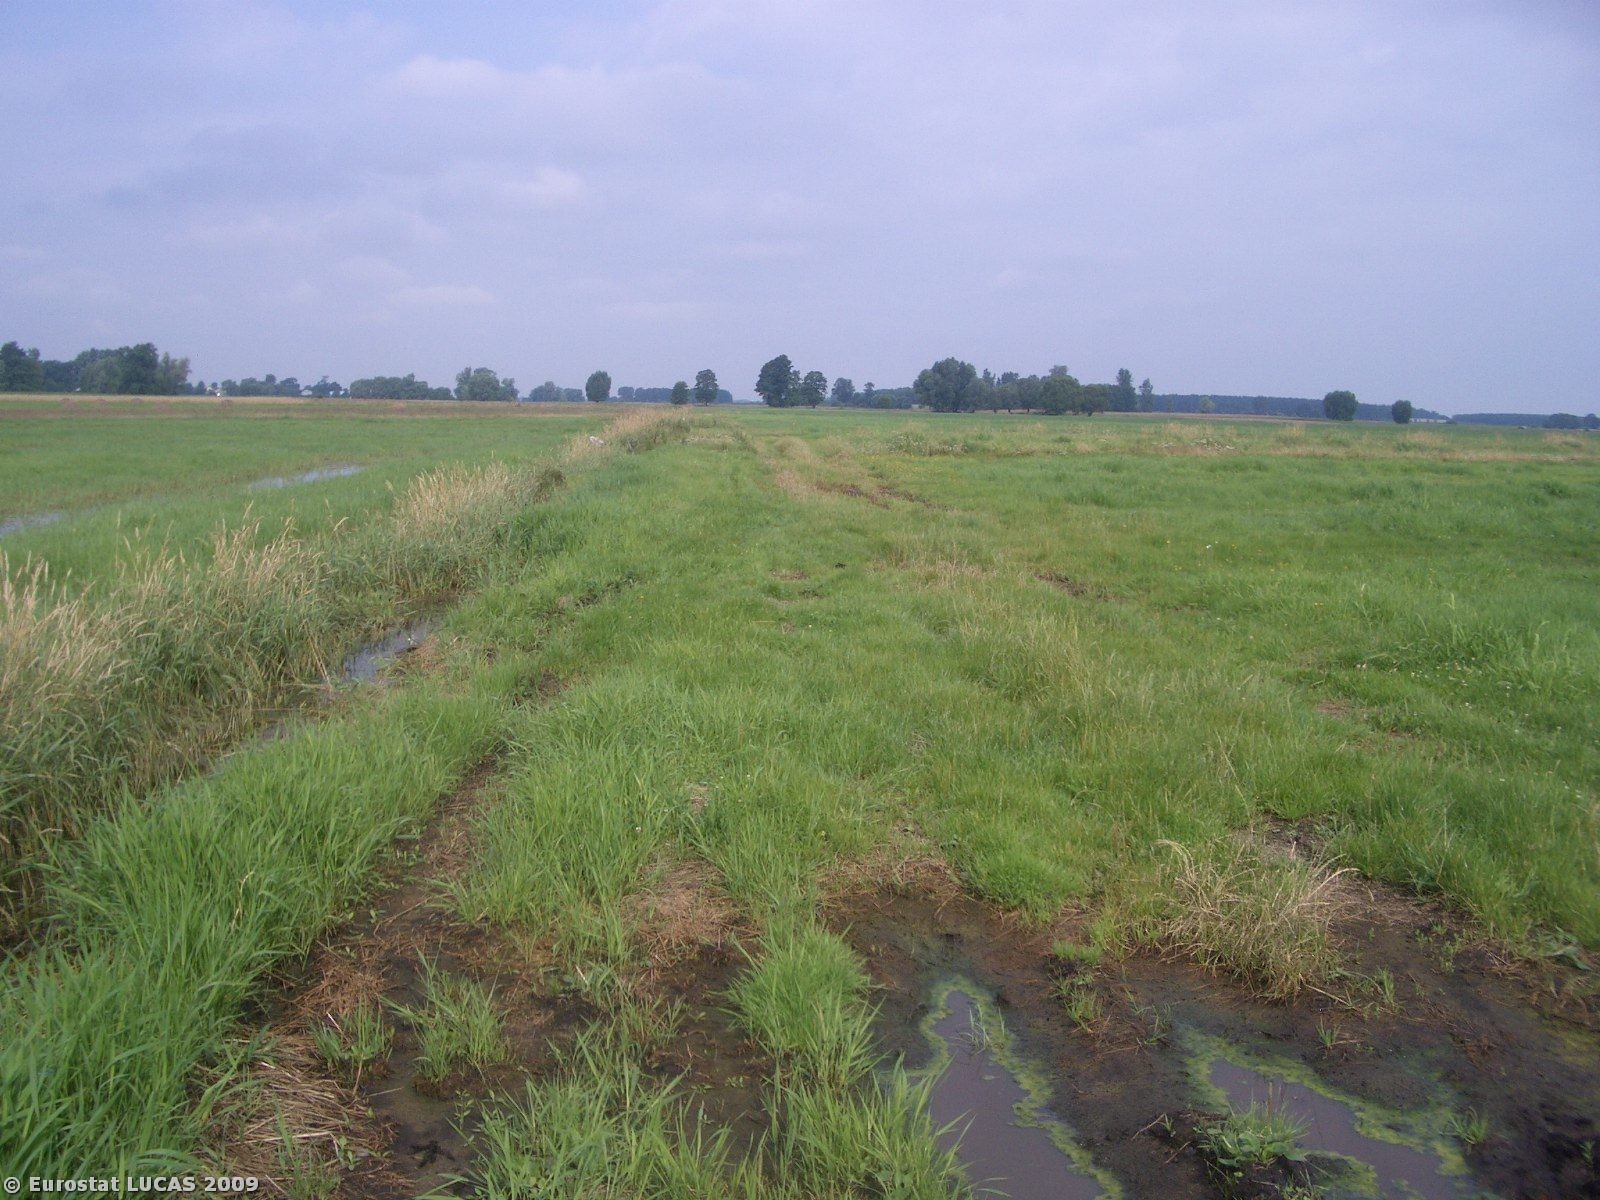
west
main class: Grassland
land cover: Grassland without tree/shrub cover
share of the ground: > 75 %
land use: Agriculture (excluding fallow land and kitchen gardens)
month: July
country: PL
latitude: 52.1023
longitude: 22.6090
